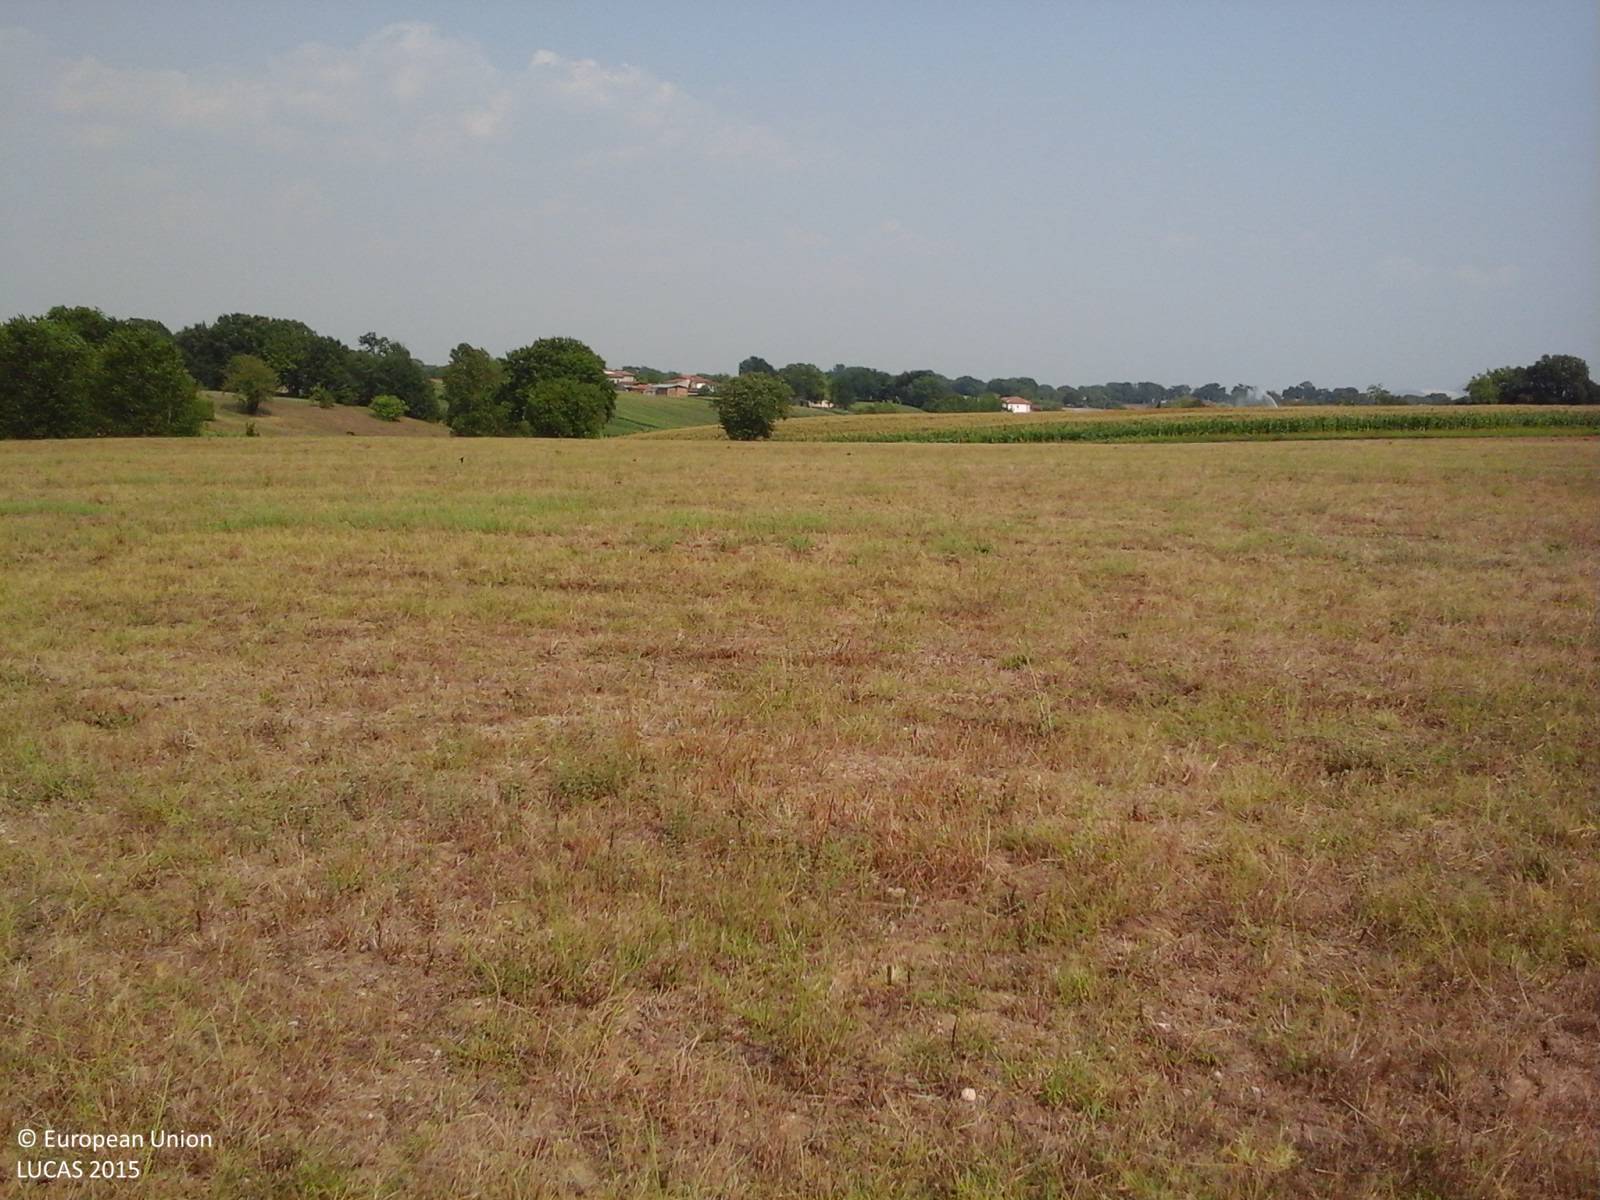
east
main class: Cropland
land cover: Temporary grasslands
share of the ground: > 75 %
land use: Agriculture (excluding fallow land and kitchen gardens)
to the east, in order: Temporary grasslands; Oats; Grass margins; Single bushes/trees; Maize
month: August
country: IT
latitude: 41.4466
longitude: 13.7083
